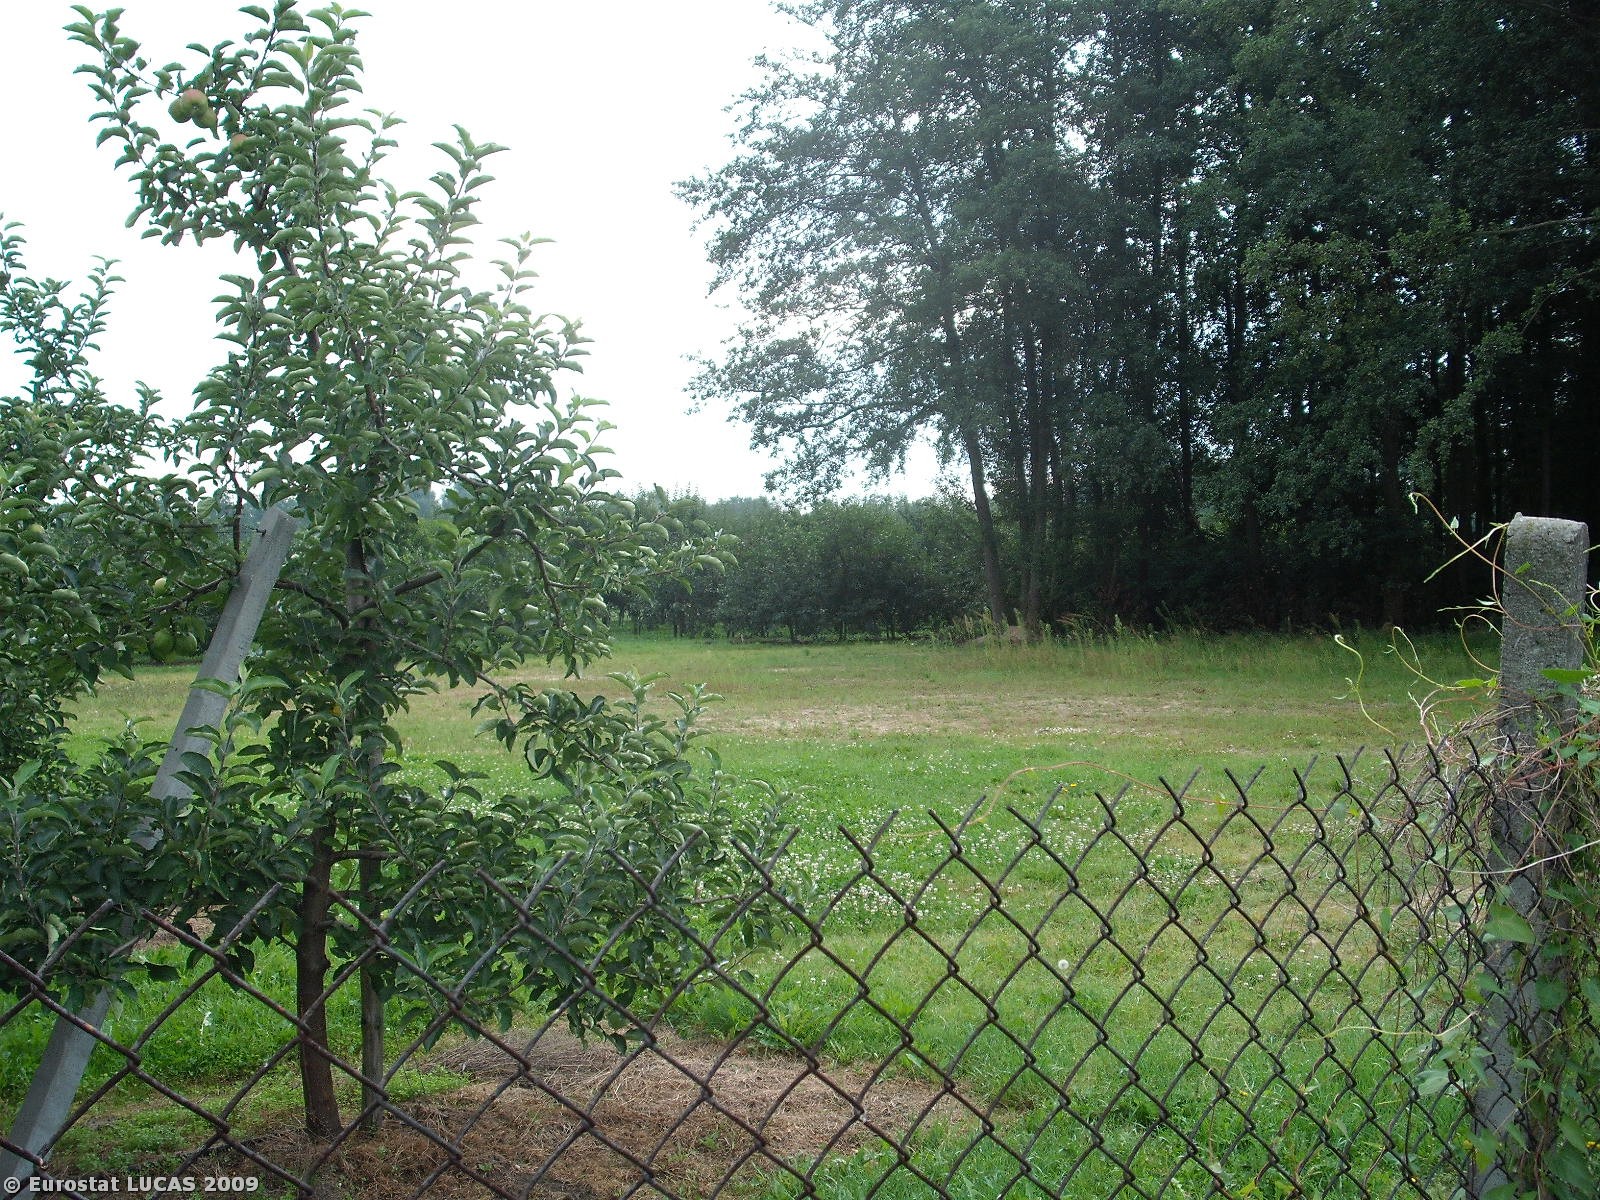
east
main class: Cropland
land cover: Apple fruit
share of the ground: 50 - 75 %
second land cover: Grassland with sparse tree/shrub cover
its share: > 75 %
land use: Agriculture (excluding fallow land and kitchen gardens)
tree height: < 5 m
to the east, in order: Apple fruit; Grassland with sparse tree/shrub cover; Inland water bodies; Apple fruit; Fences; Grassland without tree/shrub cover; Broadleaved woodland; Grassland without tree/shrub cover; Fences; Apple fruit
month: August
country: PL
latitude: 51.7615
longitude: 21.1301
